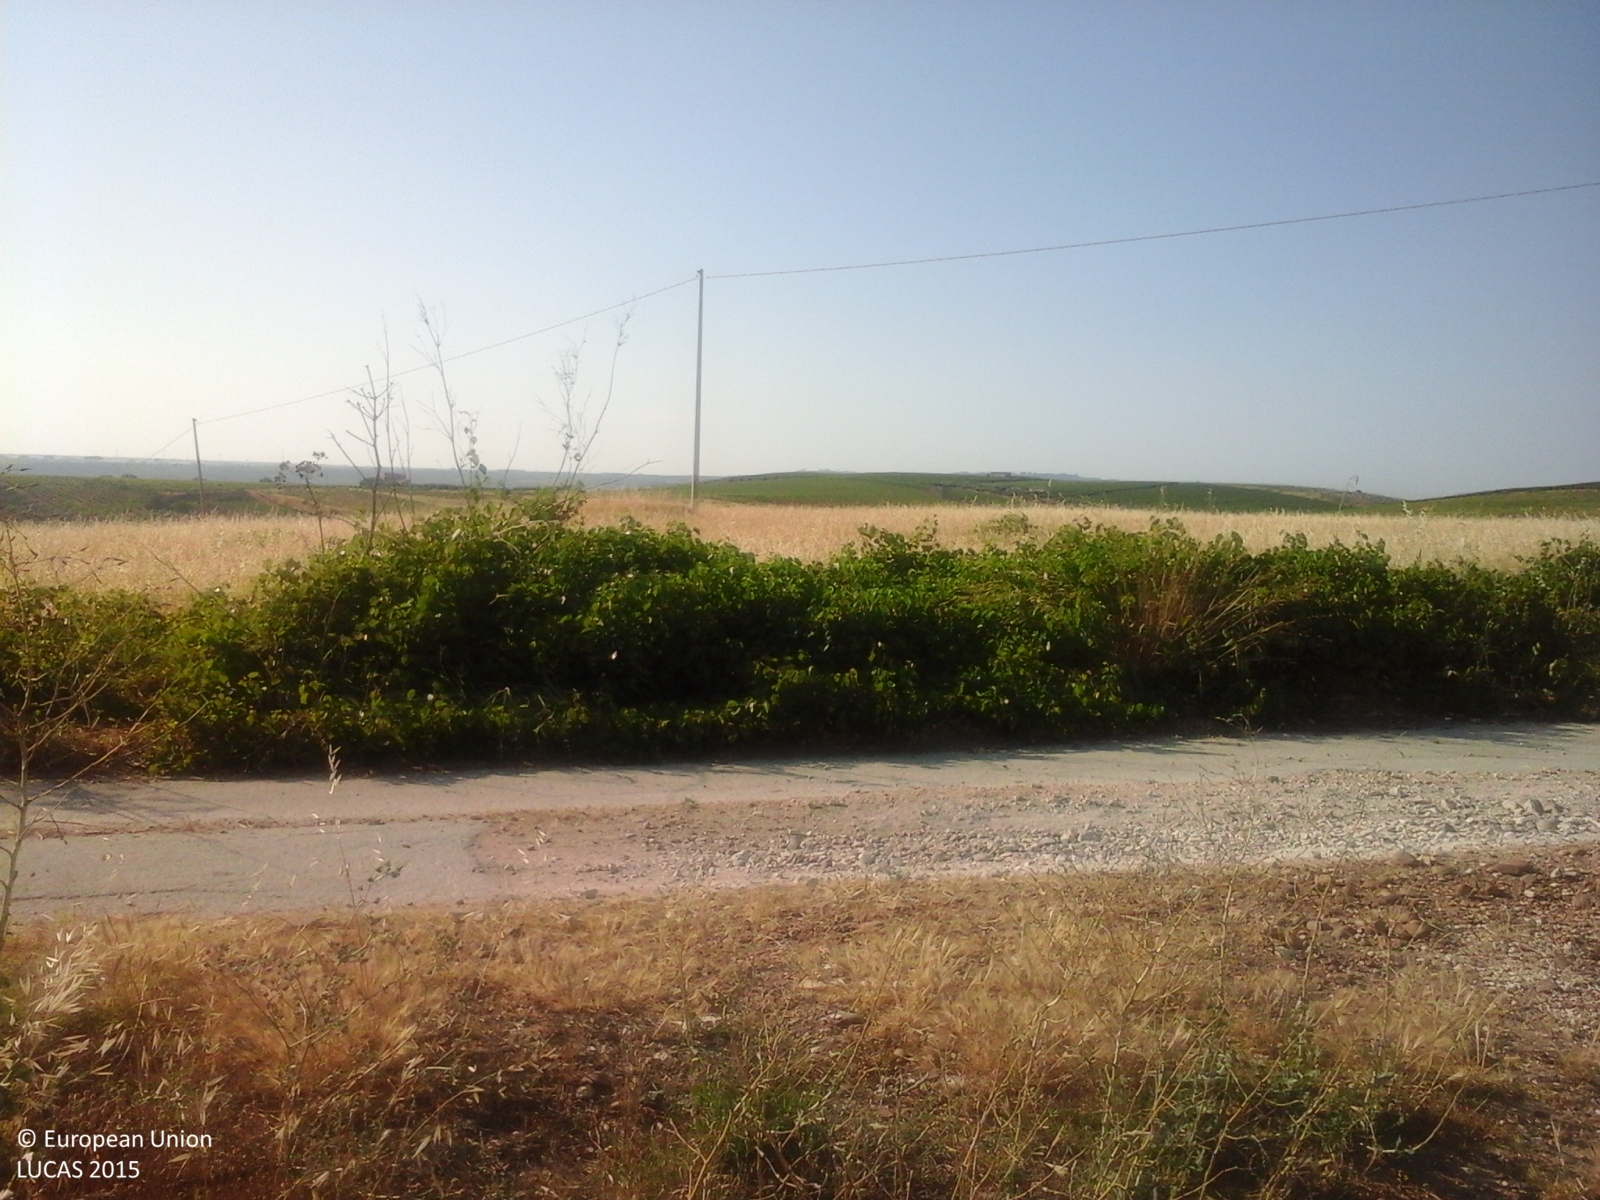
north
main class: Cropland
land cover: Vineyards
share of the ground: 25 - 50 %
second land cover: Other bare soil
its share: > 75 %
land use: Agriculture (excluding fallow land and kitchen gardens)
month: June
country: IT
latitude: 37.6484
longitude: 12.9134
